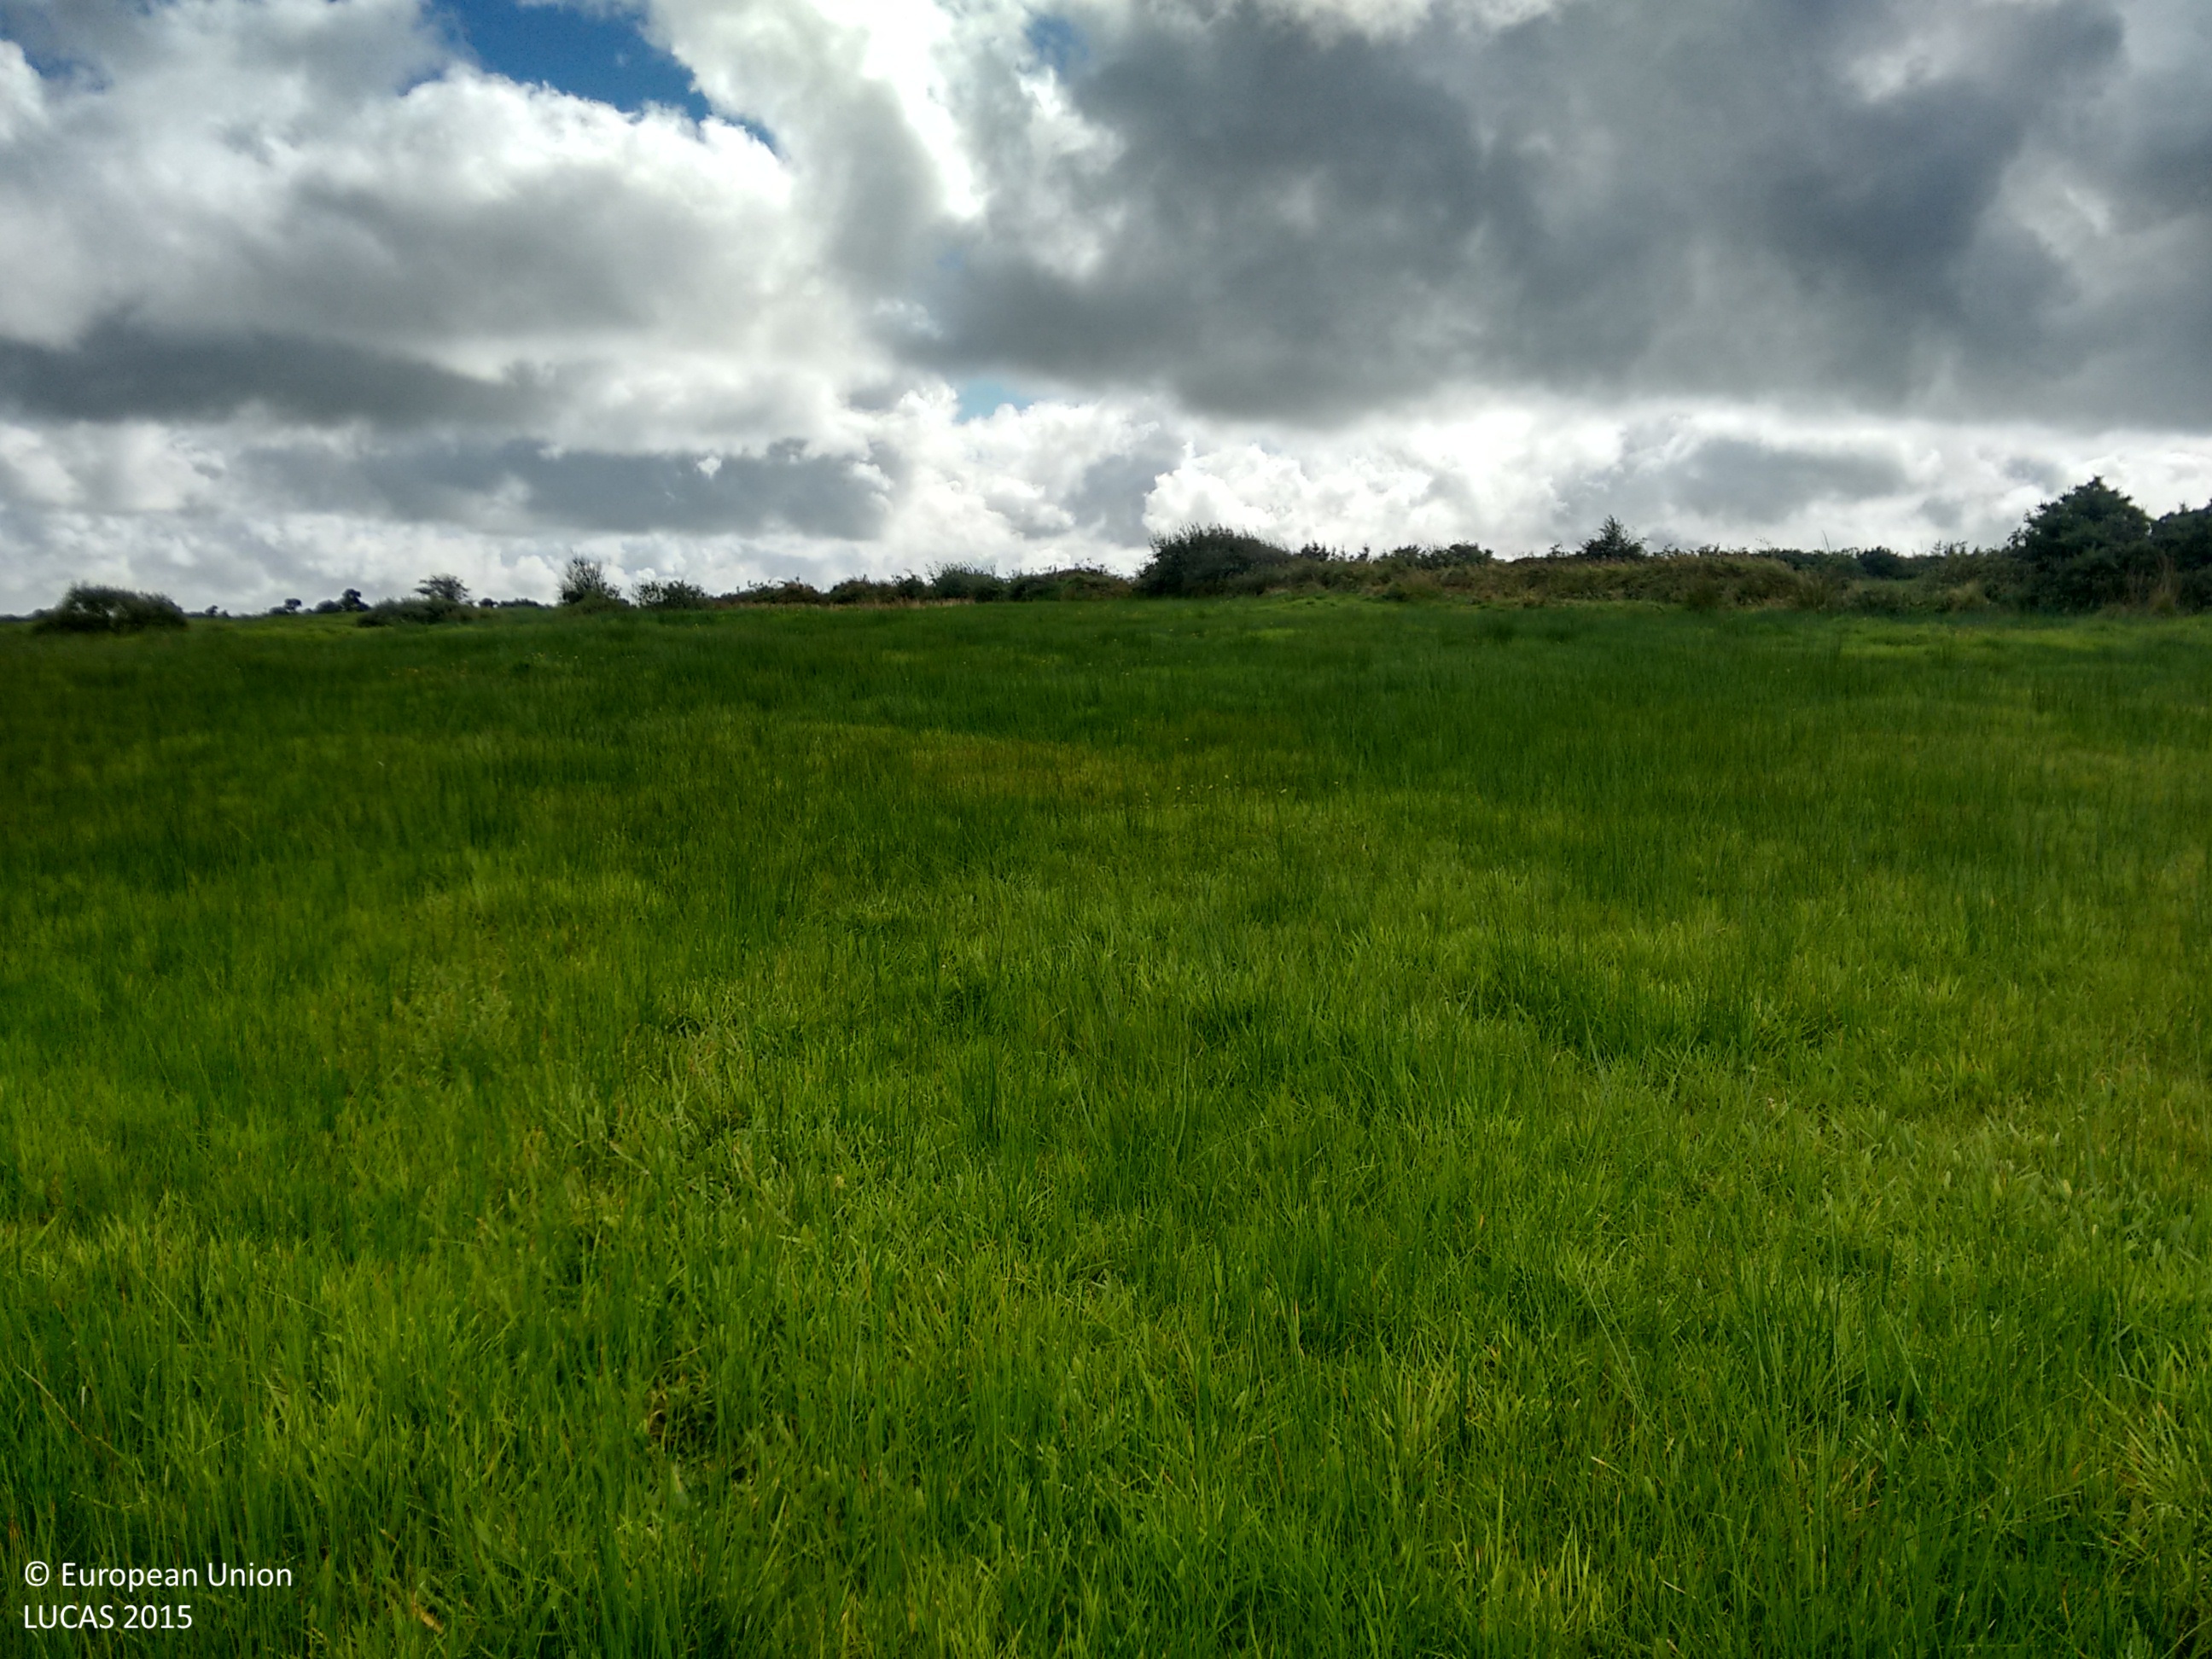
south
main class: Grassland
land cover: Grassland without tree/shrub cover
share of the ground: > 75 %
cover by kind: herbaceous plants 100 %
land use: Agriculture (excluding fallow land and kitchen gardens)
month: September
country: IE
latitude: 52.7460
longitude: -9.2280
